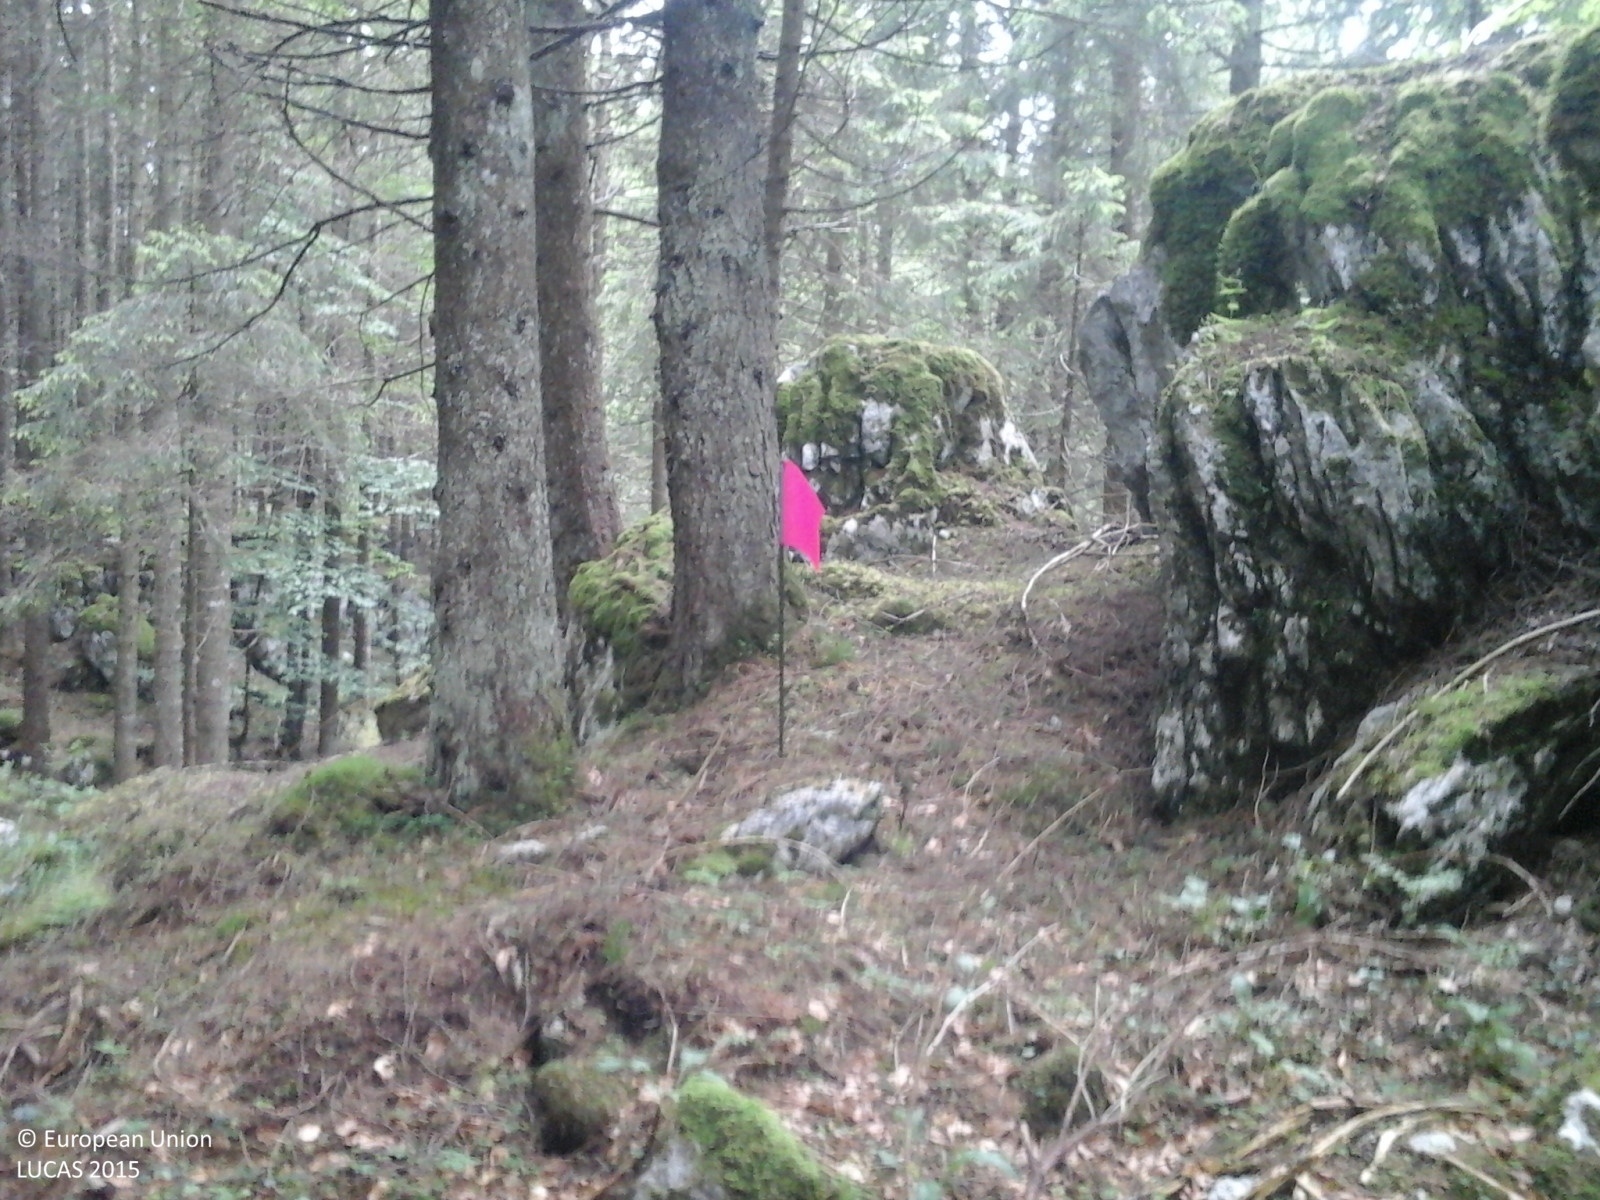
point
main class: Woodland
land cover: Spruce dominated mixed woodland
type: alpine coniferous forest
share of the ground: > 75 %
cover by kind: coniferous forest trees 75 %, broadleaved forest trees 25 %
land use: Forestry
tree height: > 5 m
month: June
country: IT
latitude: 45.8177
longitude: 11.5293
